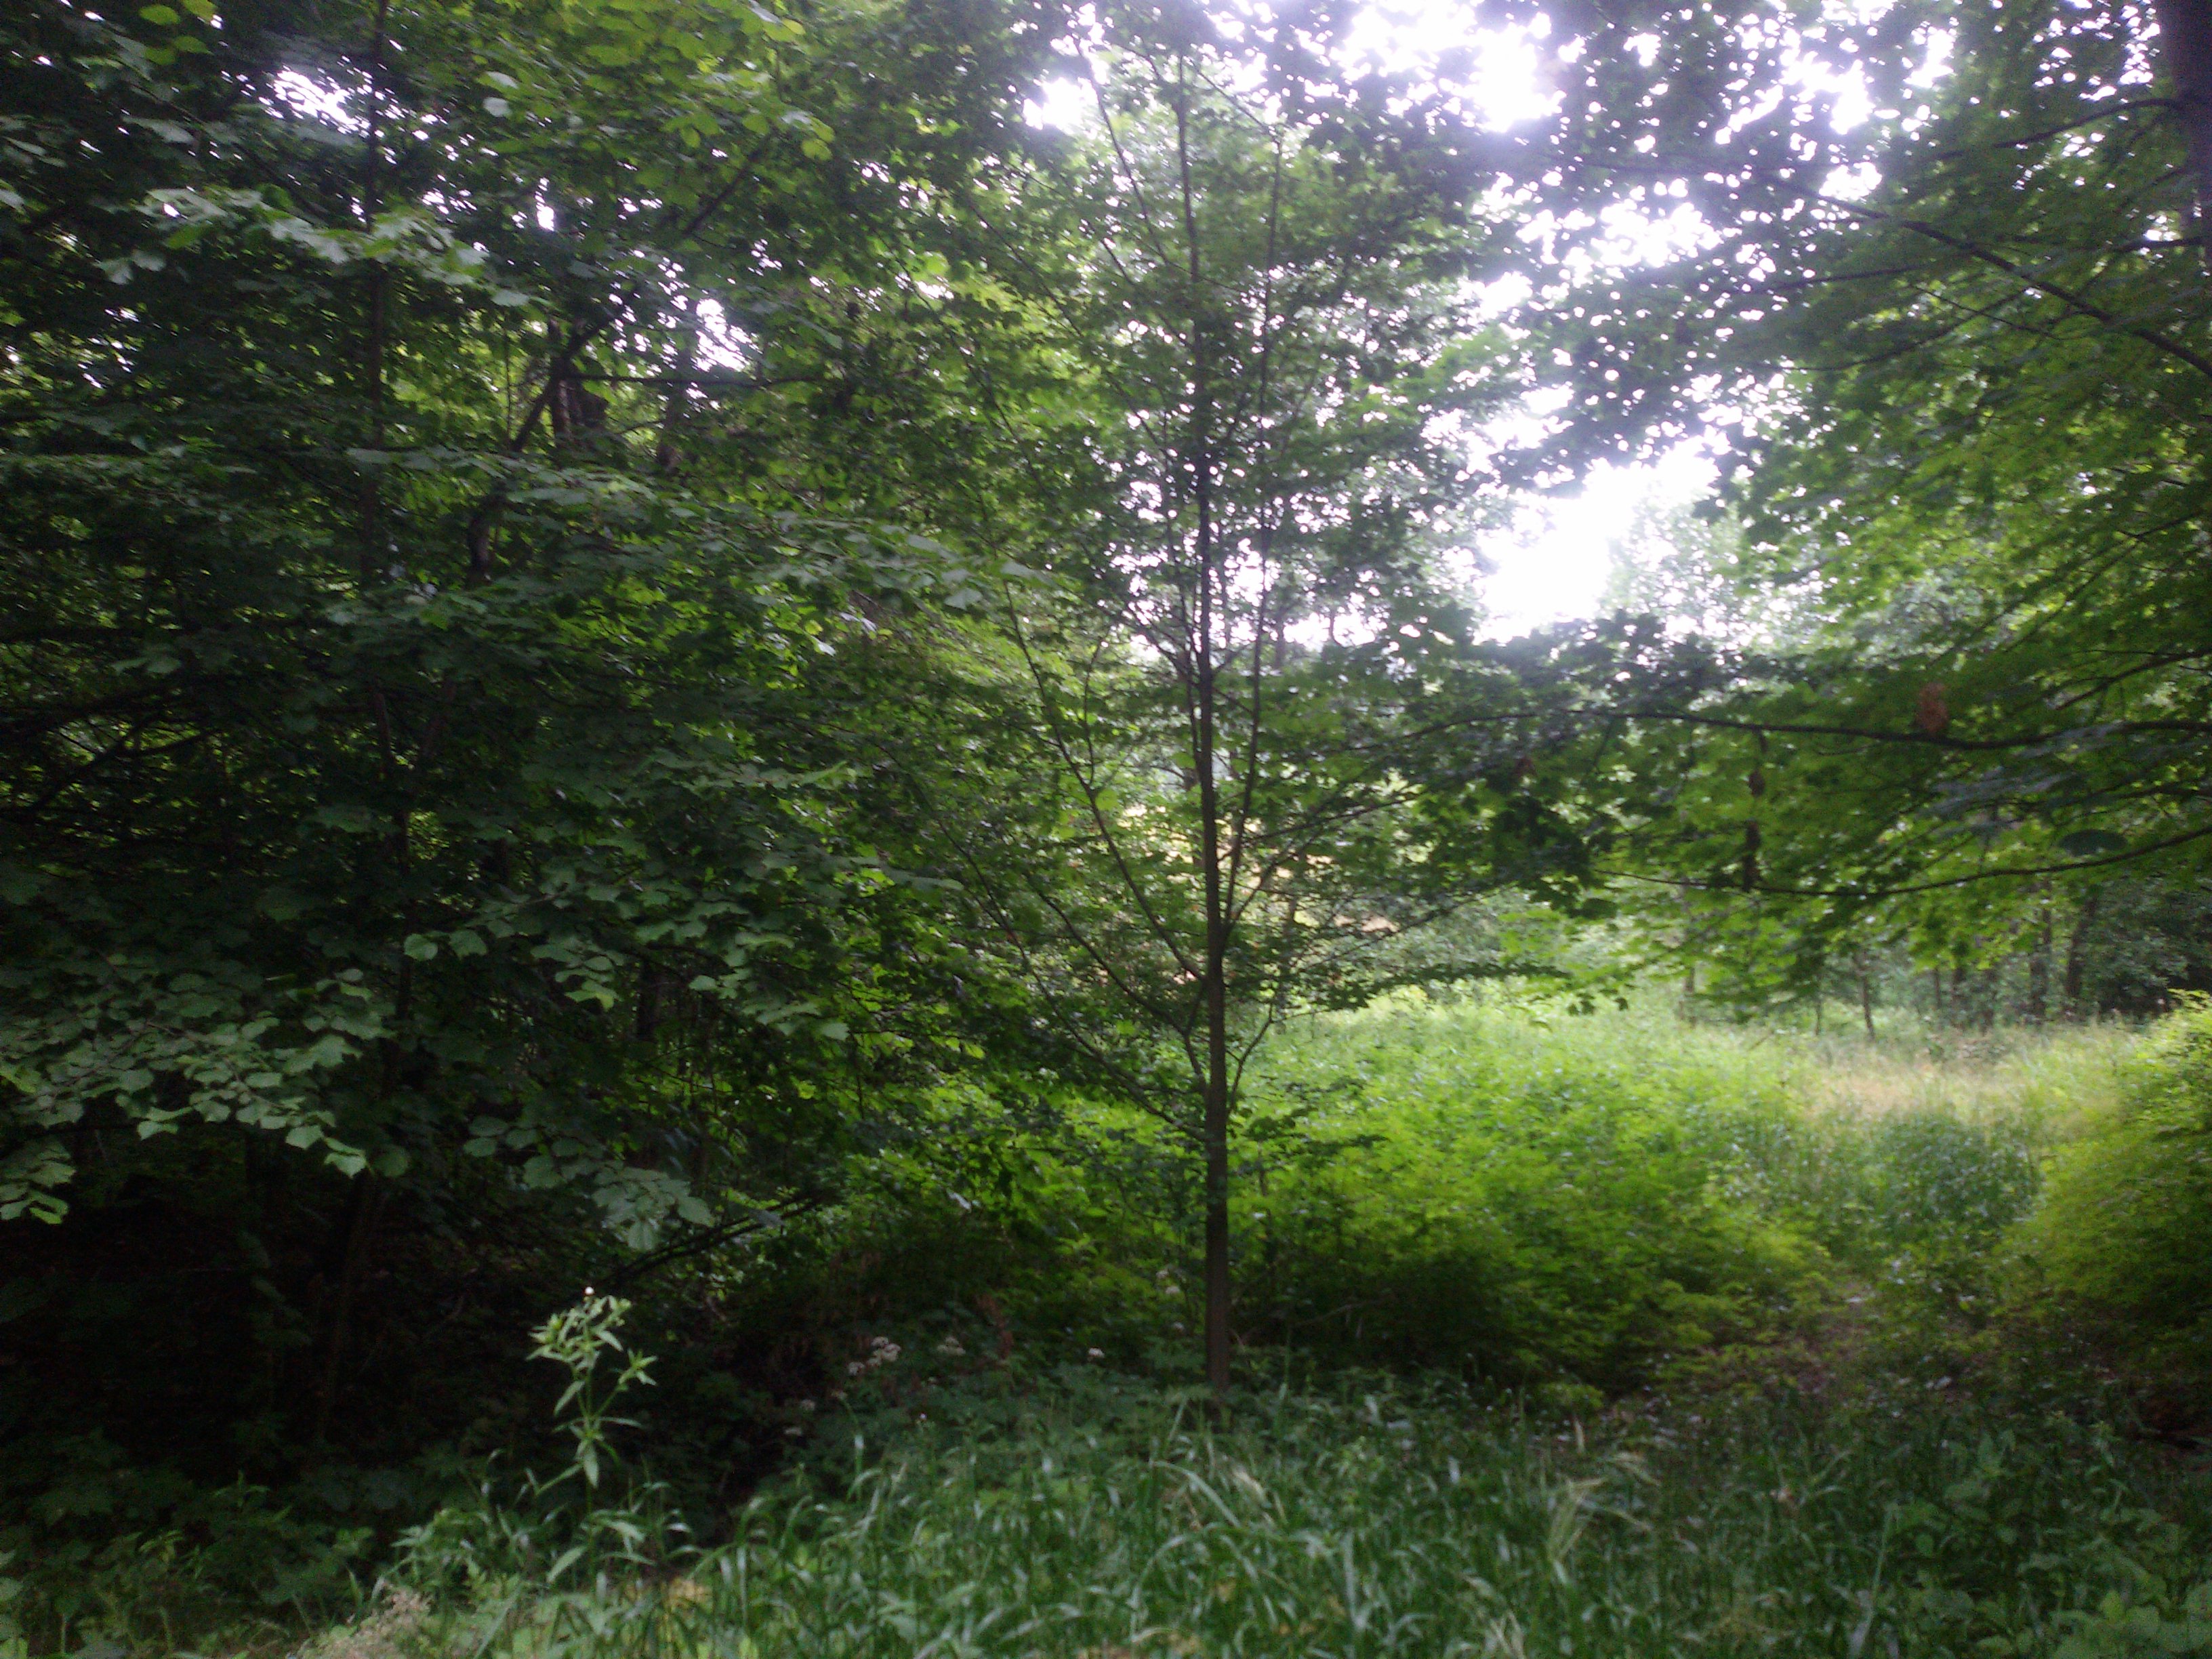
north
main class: Woodland
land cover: Broadleaved woodland
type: mesophytic deciduous forest
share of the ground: 50 - 75 %
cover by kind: broadleaved forest trees 65 %, herbaceous plants 25 %, shrubs 10 %
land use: Forestry
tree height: > 5 m
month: June
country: PL
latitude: 49.9328
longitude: 22.3079
